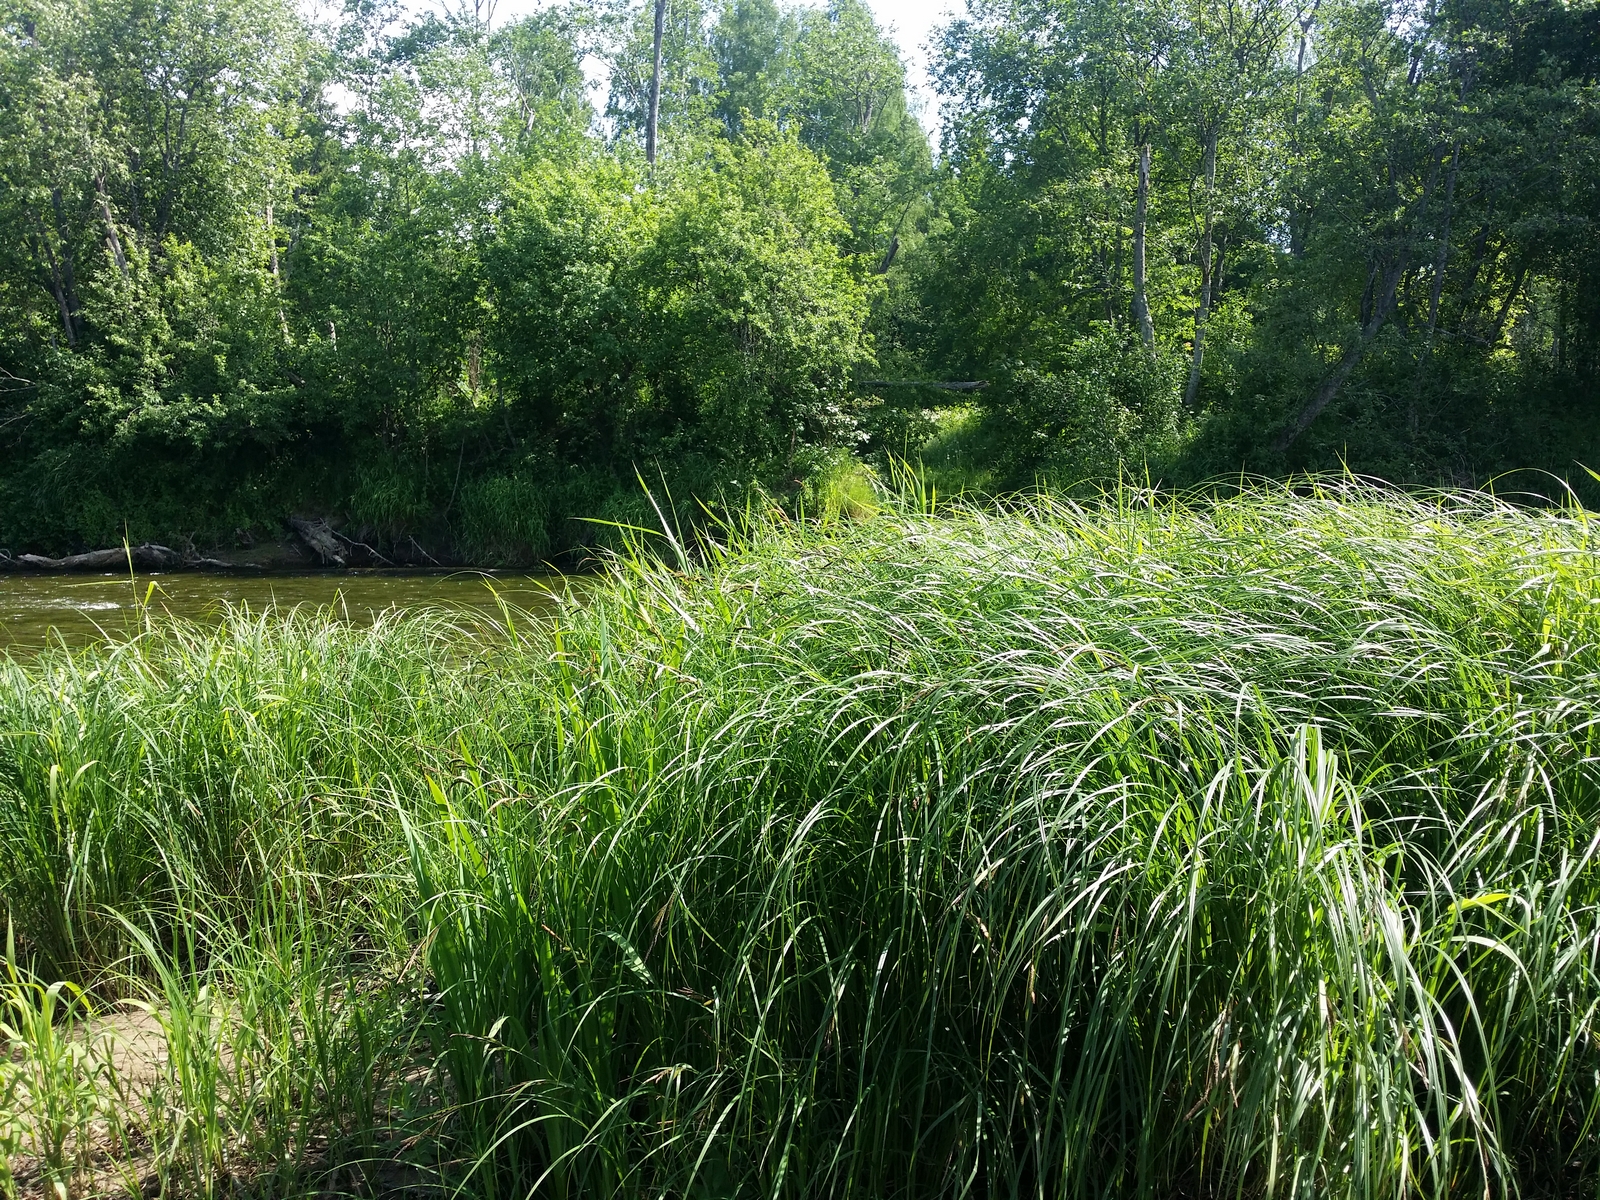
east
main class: Grassland
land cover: Spontaneously vegetated surfaces
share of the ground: 50 - 75 %
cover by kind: herbaceous plants 60 %, unconsolidated bare surface 40 %
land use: Semi-natural and natural areas not in use
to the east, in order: Spontaneously vegetated surfaces; Inland fresh running water; Broadleaved woodland; Spontaneously vegetated surfaces; Spruce dominated mixed woodland; Shruby margins; Electric lines; Shruby margins; Spruce dominated mixed woodland
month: June
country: LV
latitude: 57.3955
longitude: 26.4657
